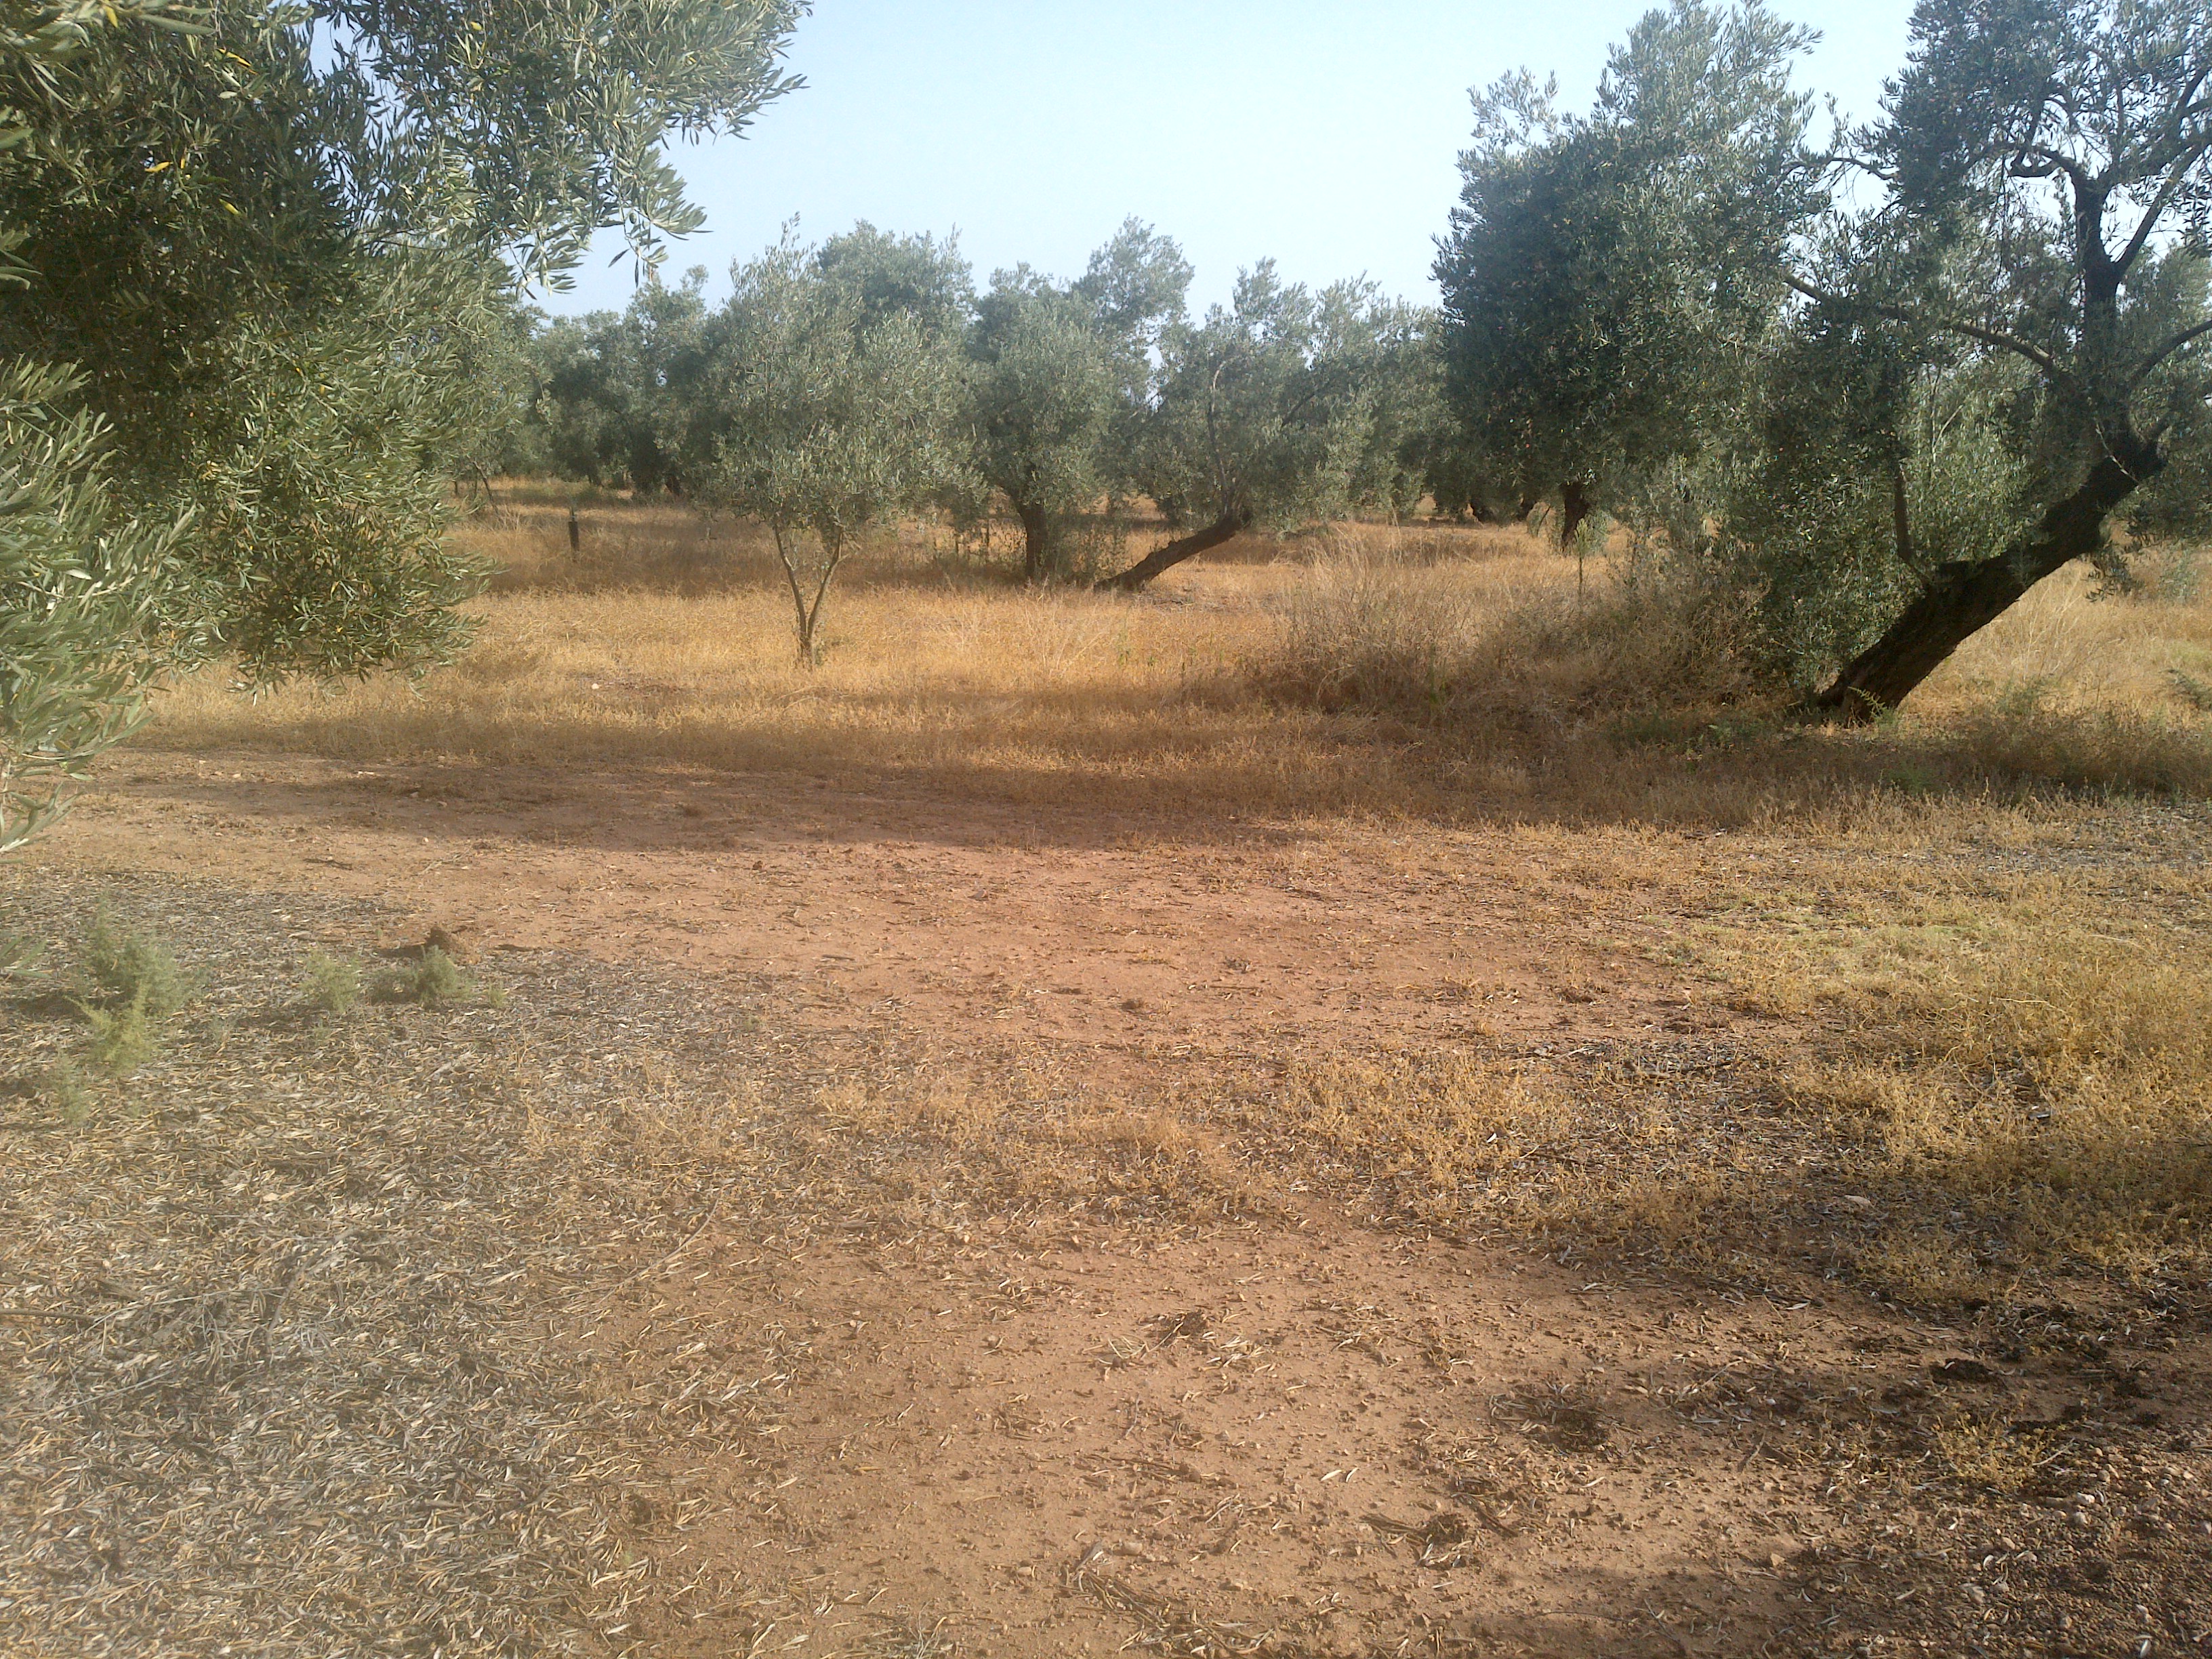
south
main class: Cropland
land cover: Olive groves
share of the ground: 50 - 75 %
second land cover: Spontaneously vegetated surfaces
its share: 10 - 25 %
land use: Agriculture (excluding fallow land and kitchen gardens)
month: July
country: ES
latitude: 37.4717
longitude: -4.8777
